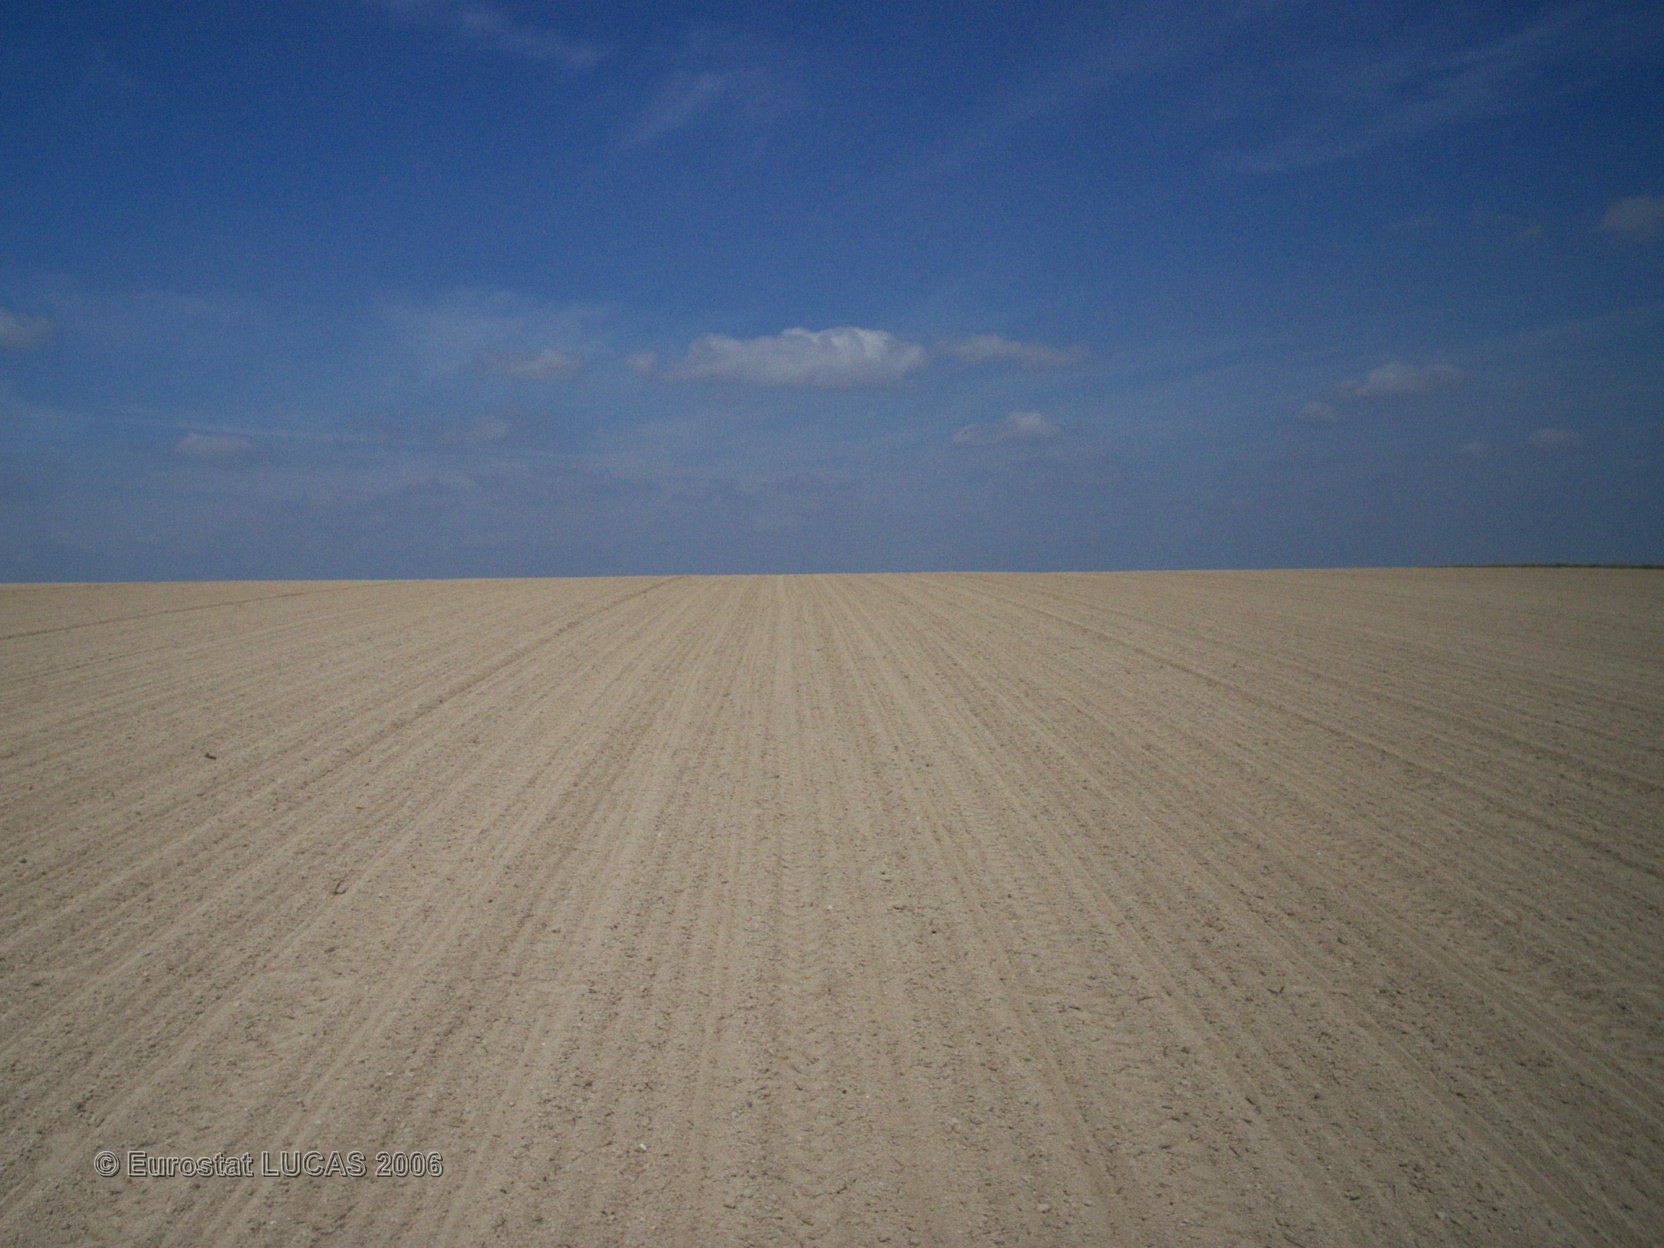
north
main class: Cropland
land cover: Sugar beet
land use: Agriculture (excluding fallow land and kitchen gardens)
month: June
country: FR
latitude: 49.2343
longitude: 4.3791
